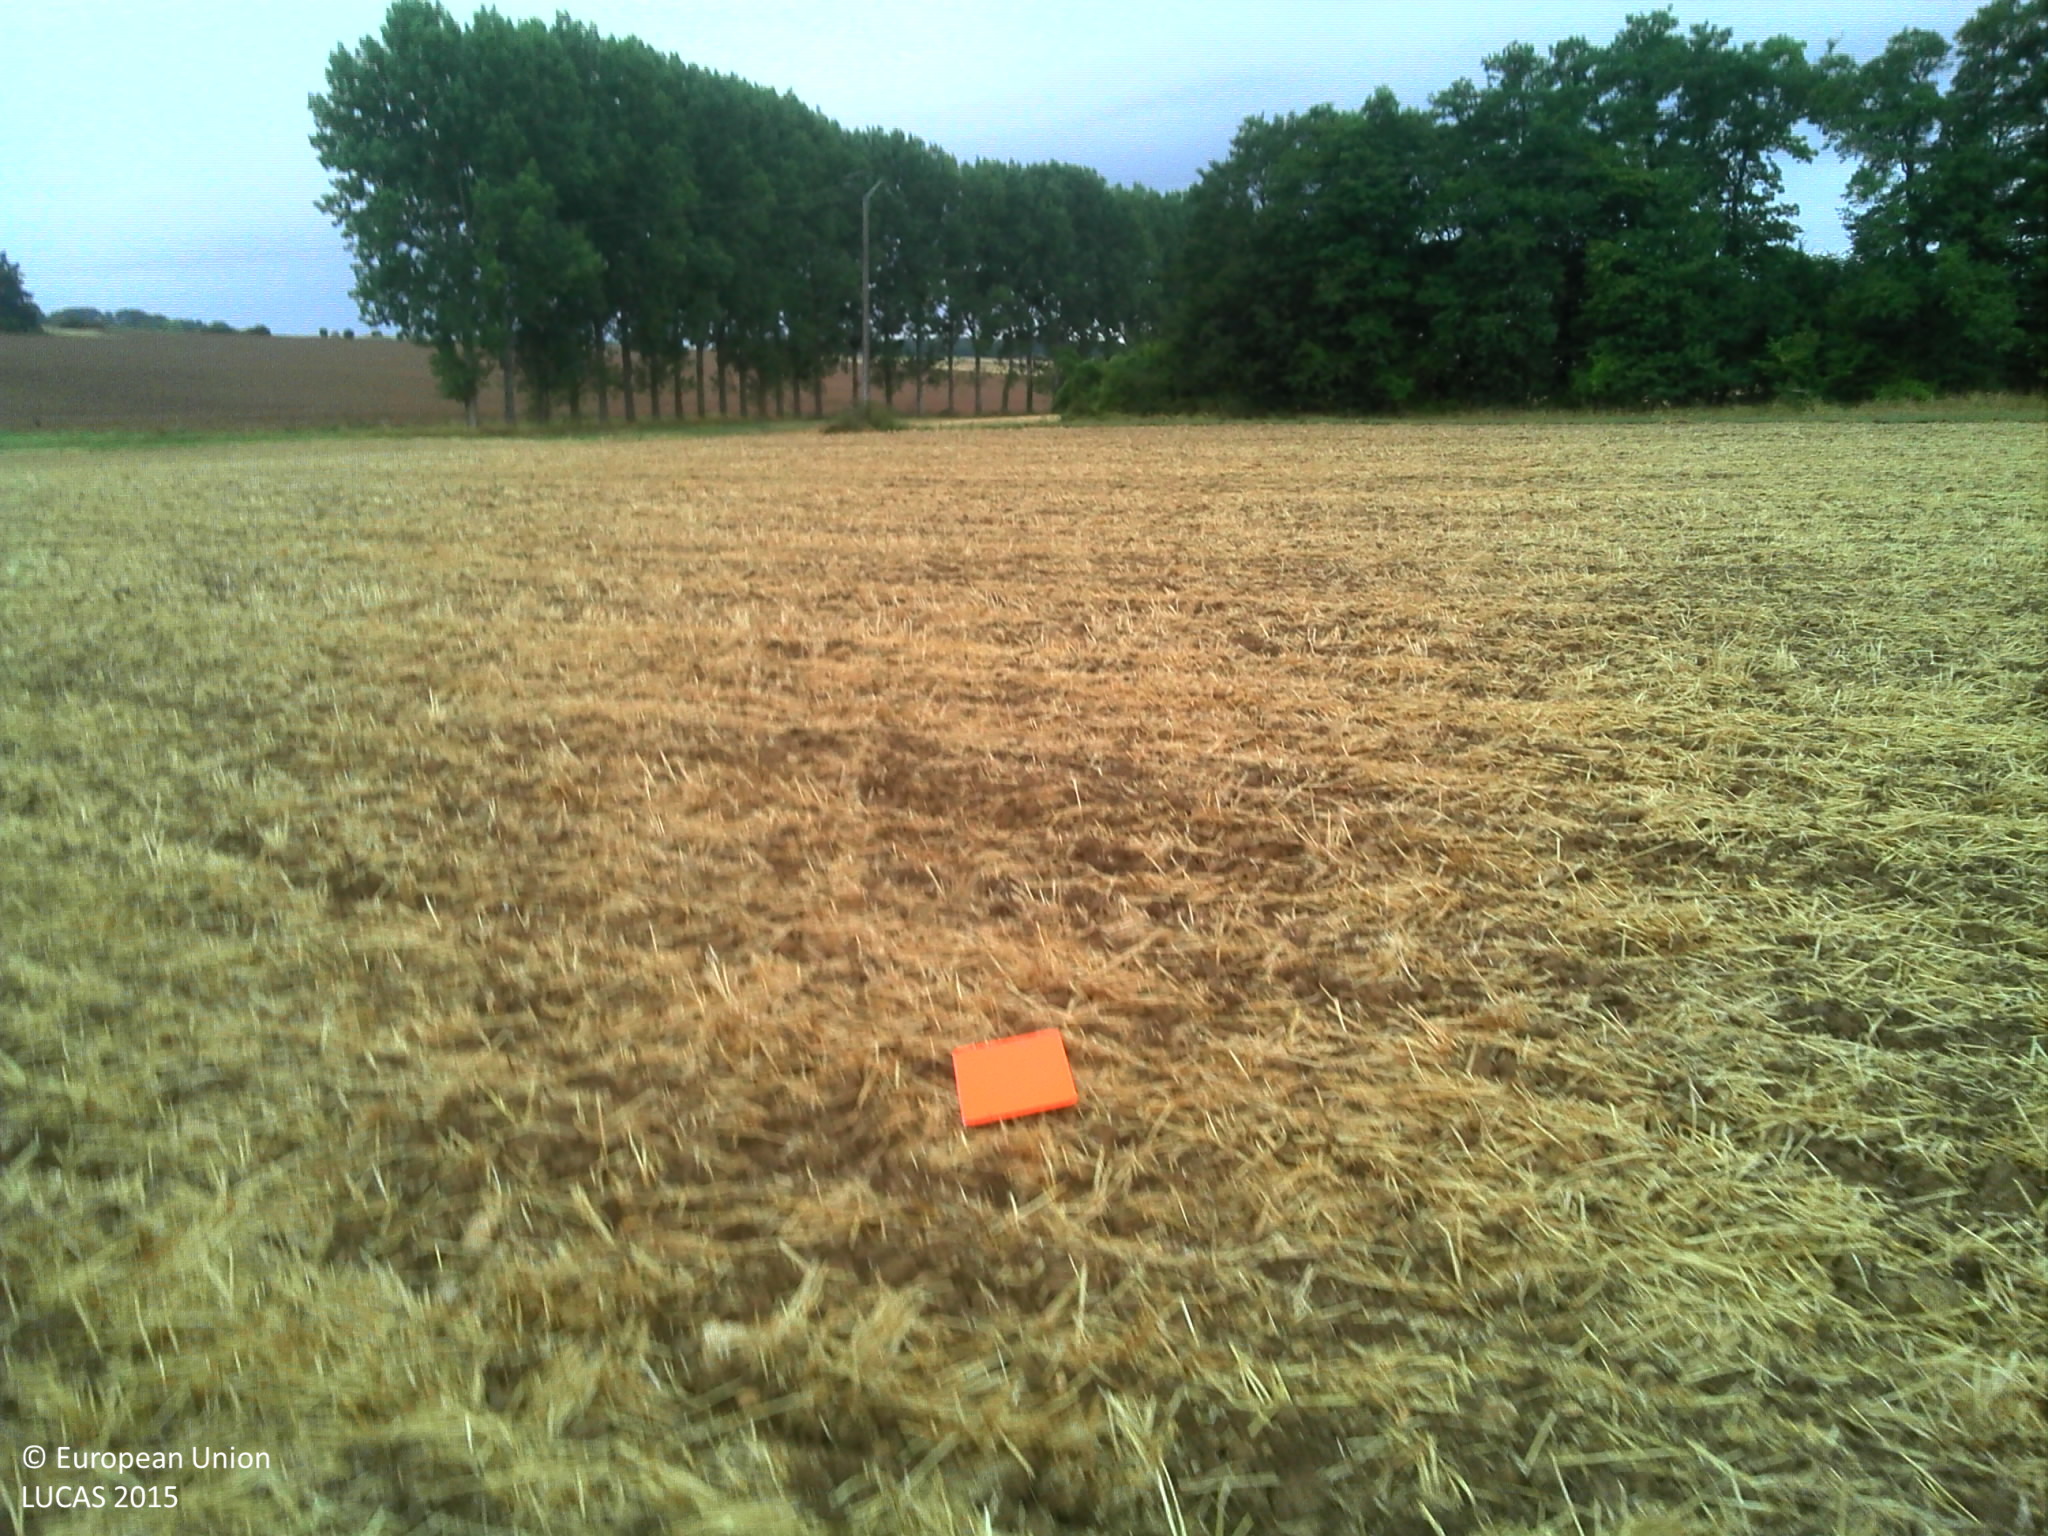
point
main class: Cropland
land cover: Common wheat
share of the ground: > 75 %
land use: Agriculture (excluding fallow land and kitchen gardens)
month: August
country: FR
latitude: 48.5279
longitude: 3.3446
